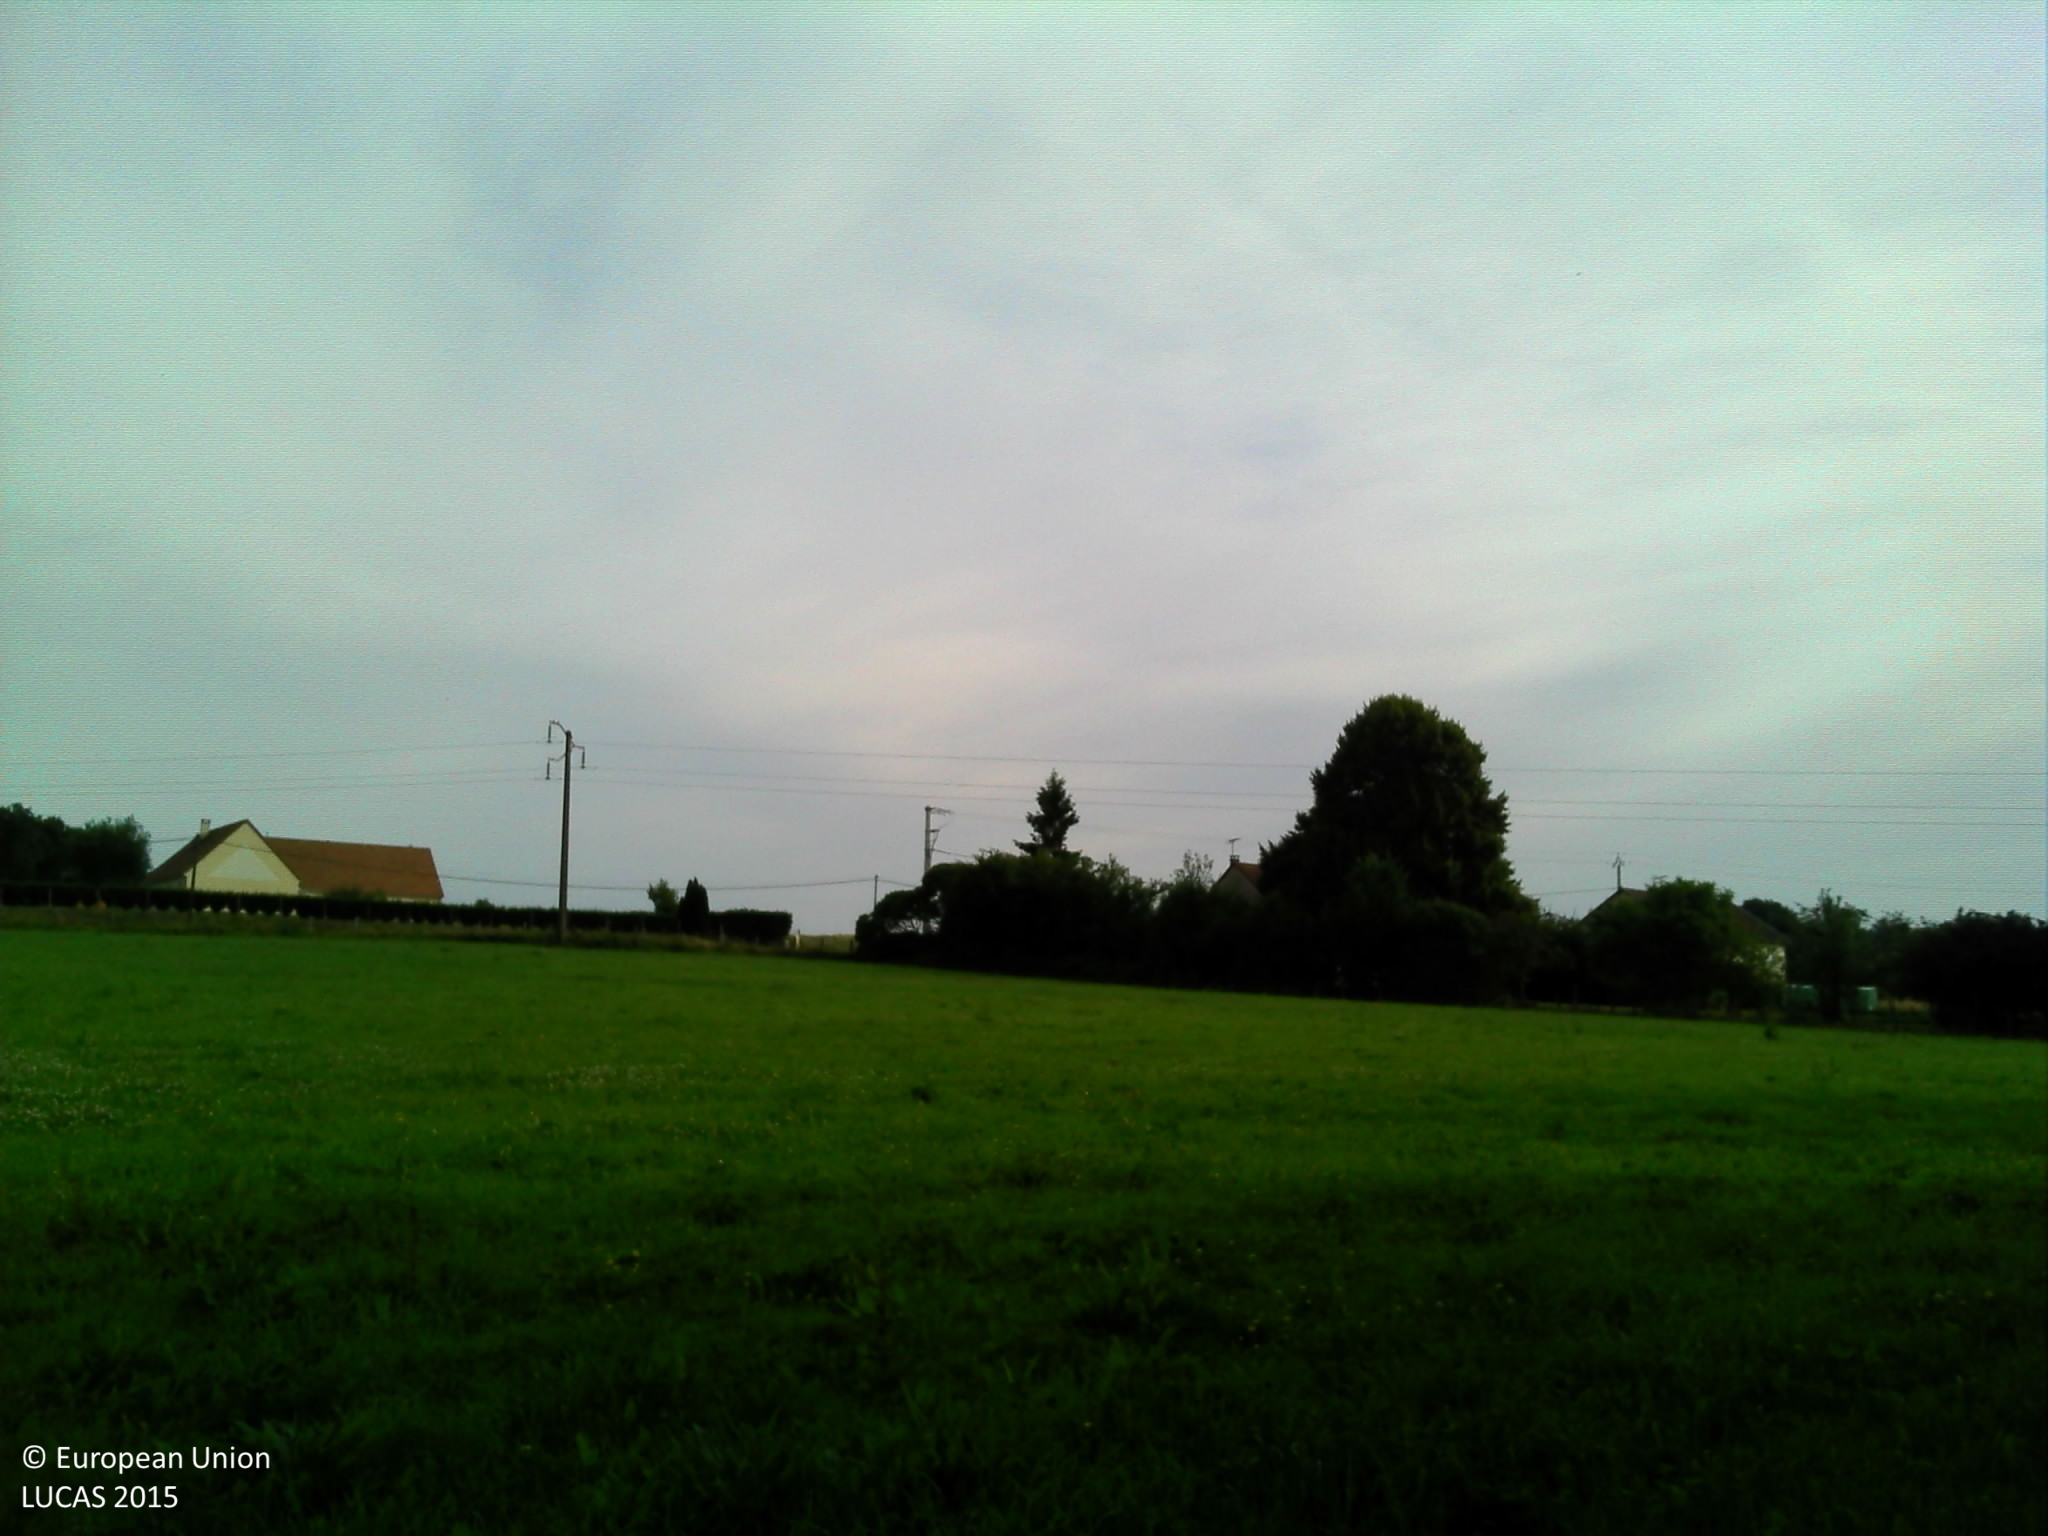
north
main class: Cropland
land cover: Rape and turnip rape
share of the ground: > 75 %
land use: Agriculture (excluding fallow land and kitchen gardens)
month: June
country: FR
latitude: 48.3623
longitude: 0.1599
